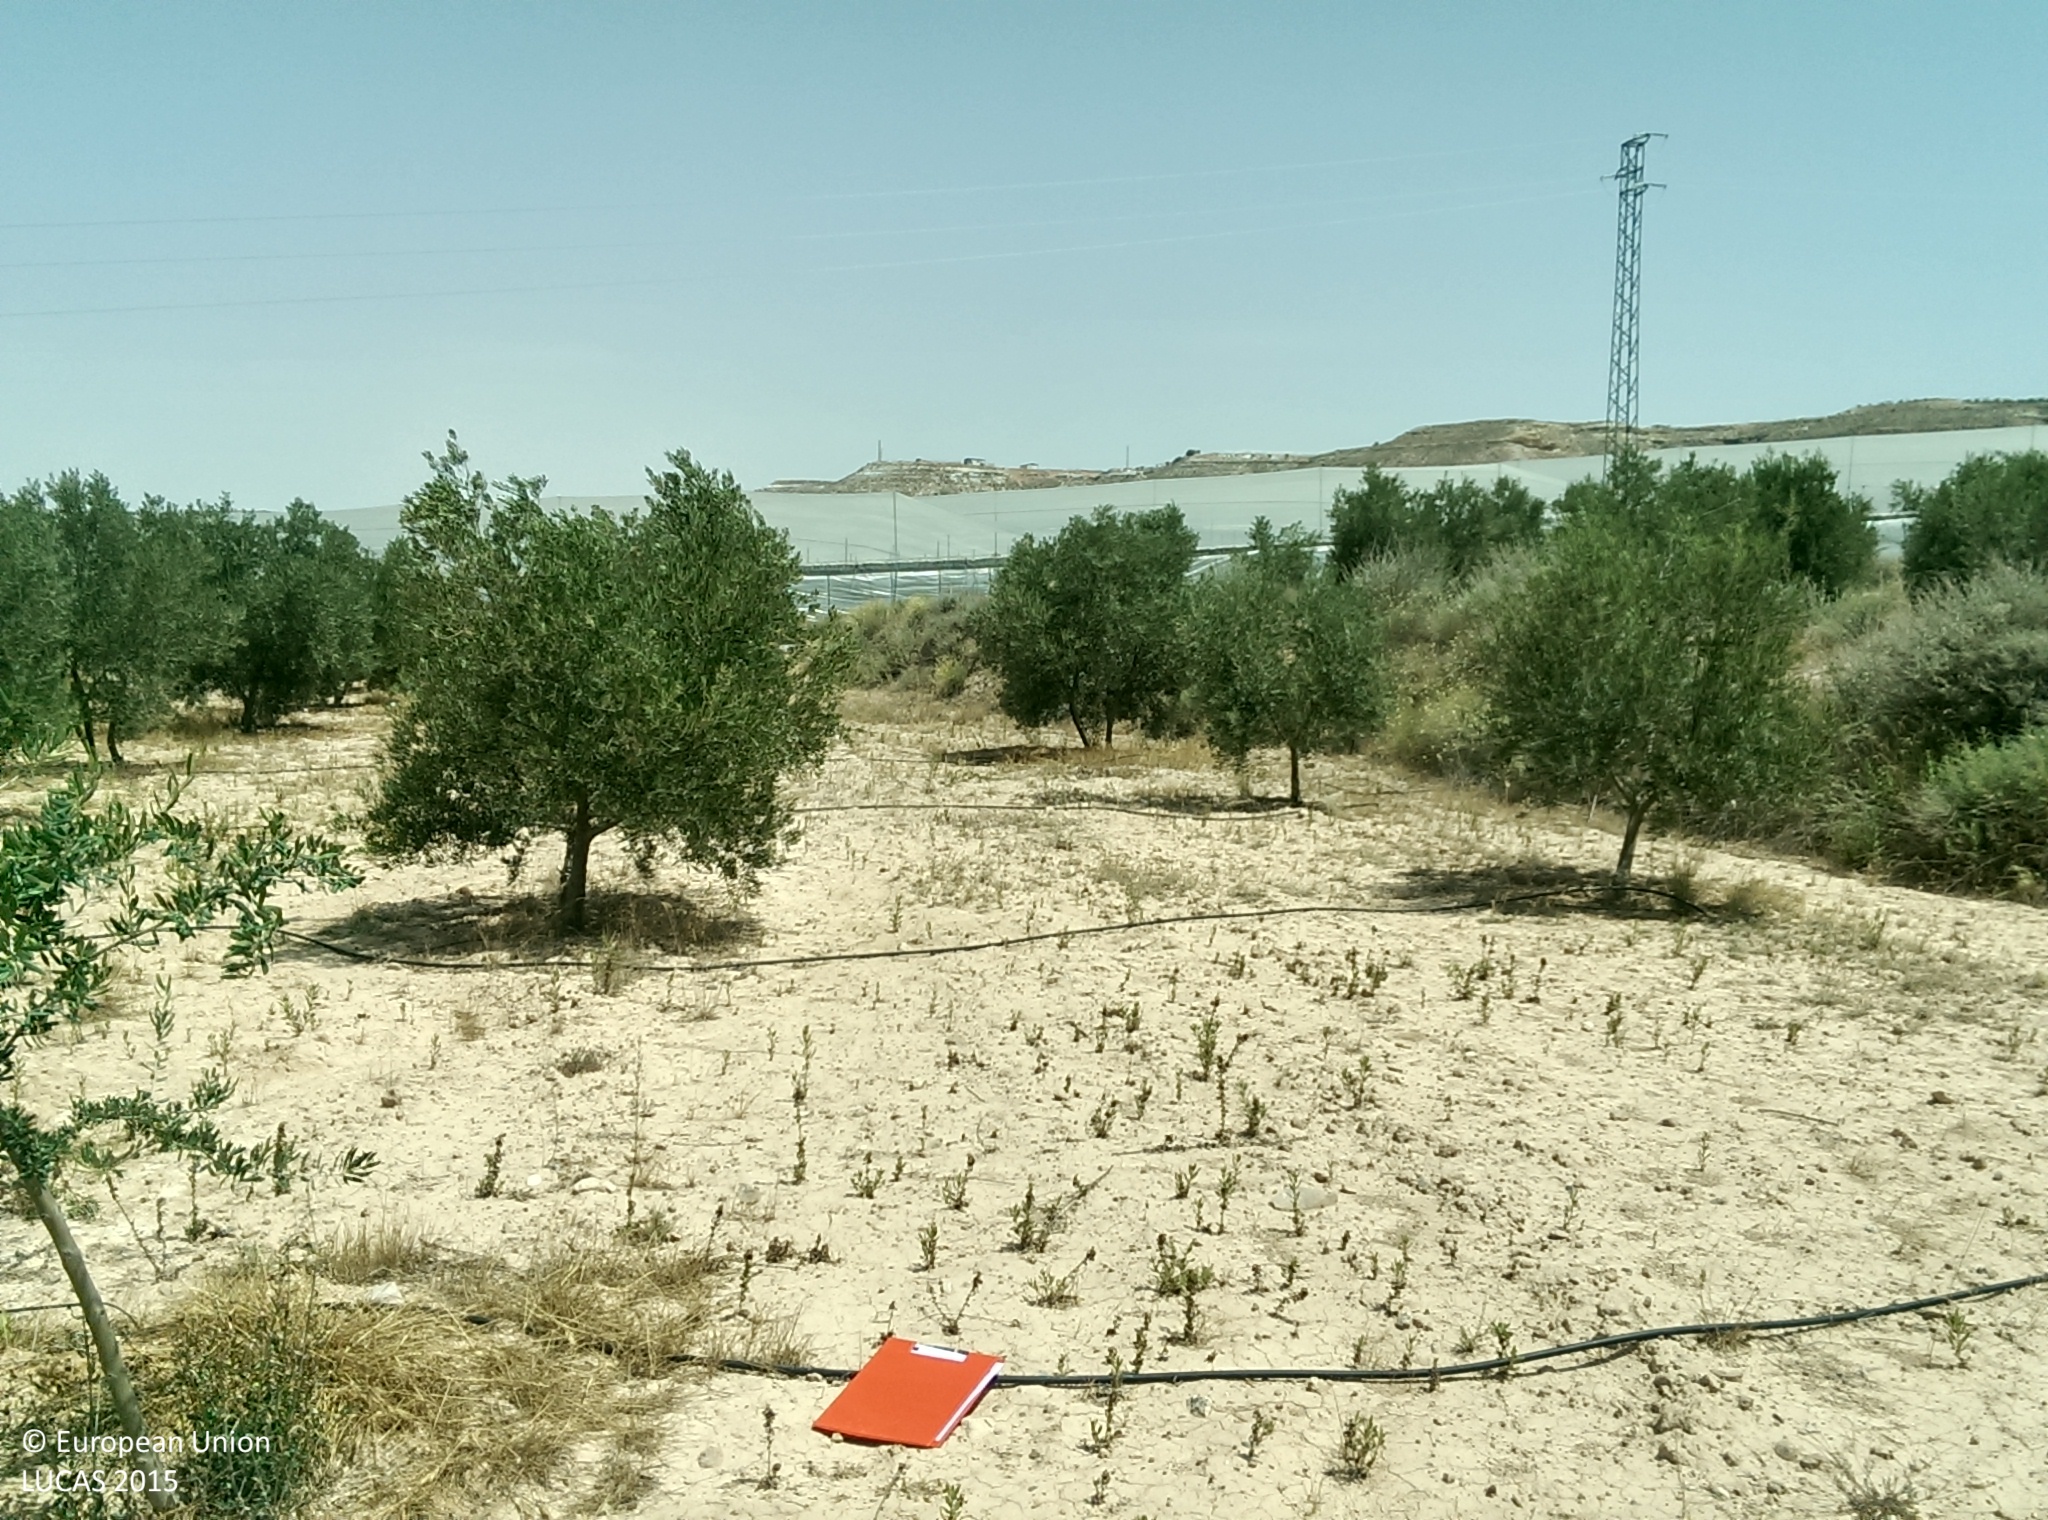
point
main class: Cropland
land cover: Olive groves
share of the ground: 25 - 50 %
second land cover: Other bare soil
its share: > 75 %
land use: Agriculture (excluding fallow land and kitchen gardens)
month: July
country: ES
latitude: 37.5313
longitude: -2.8549
